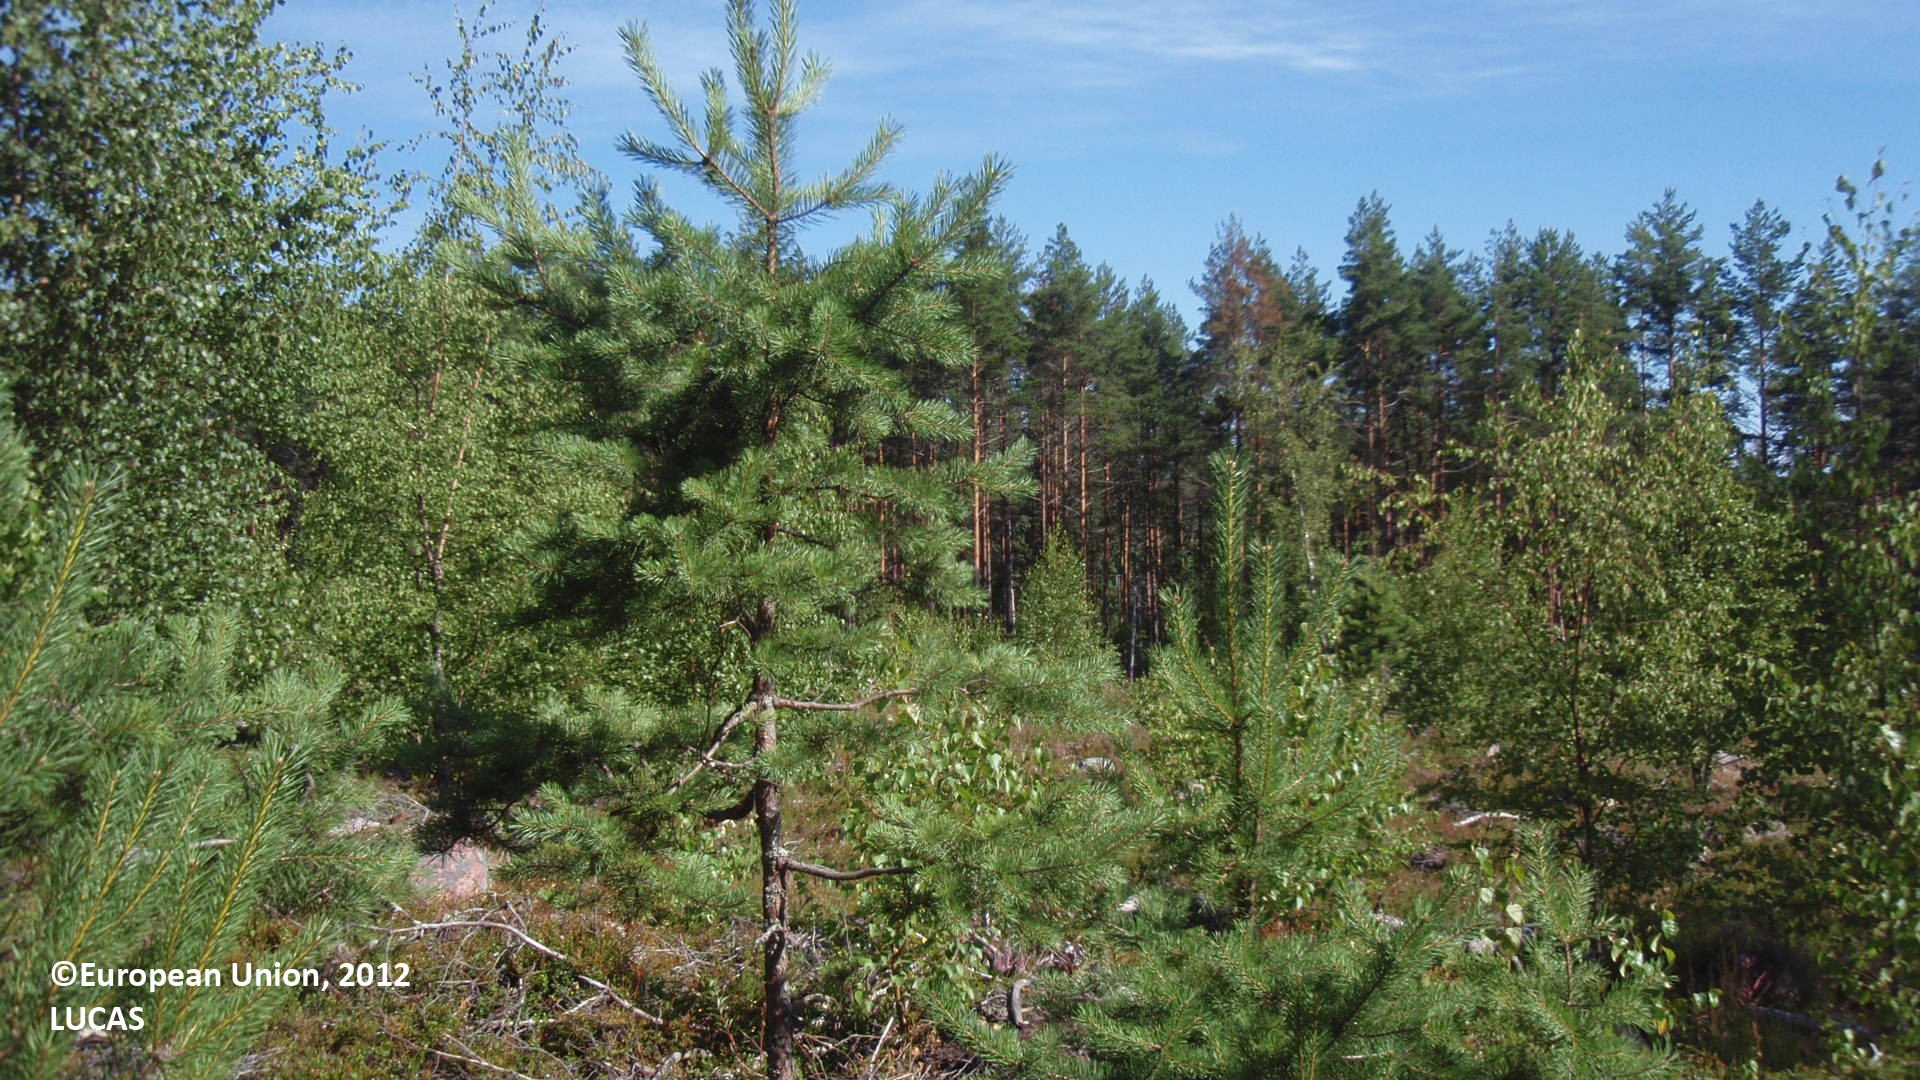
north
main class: Grassland
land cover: Grassland with sparse tree/shrub cover
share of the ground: > 75 %
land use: Forestry
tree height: > 5 m
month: July
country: FI
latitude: 61.4212
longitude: 28.1332
